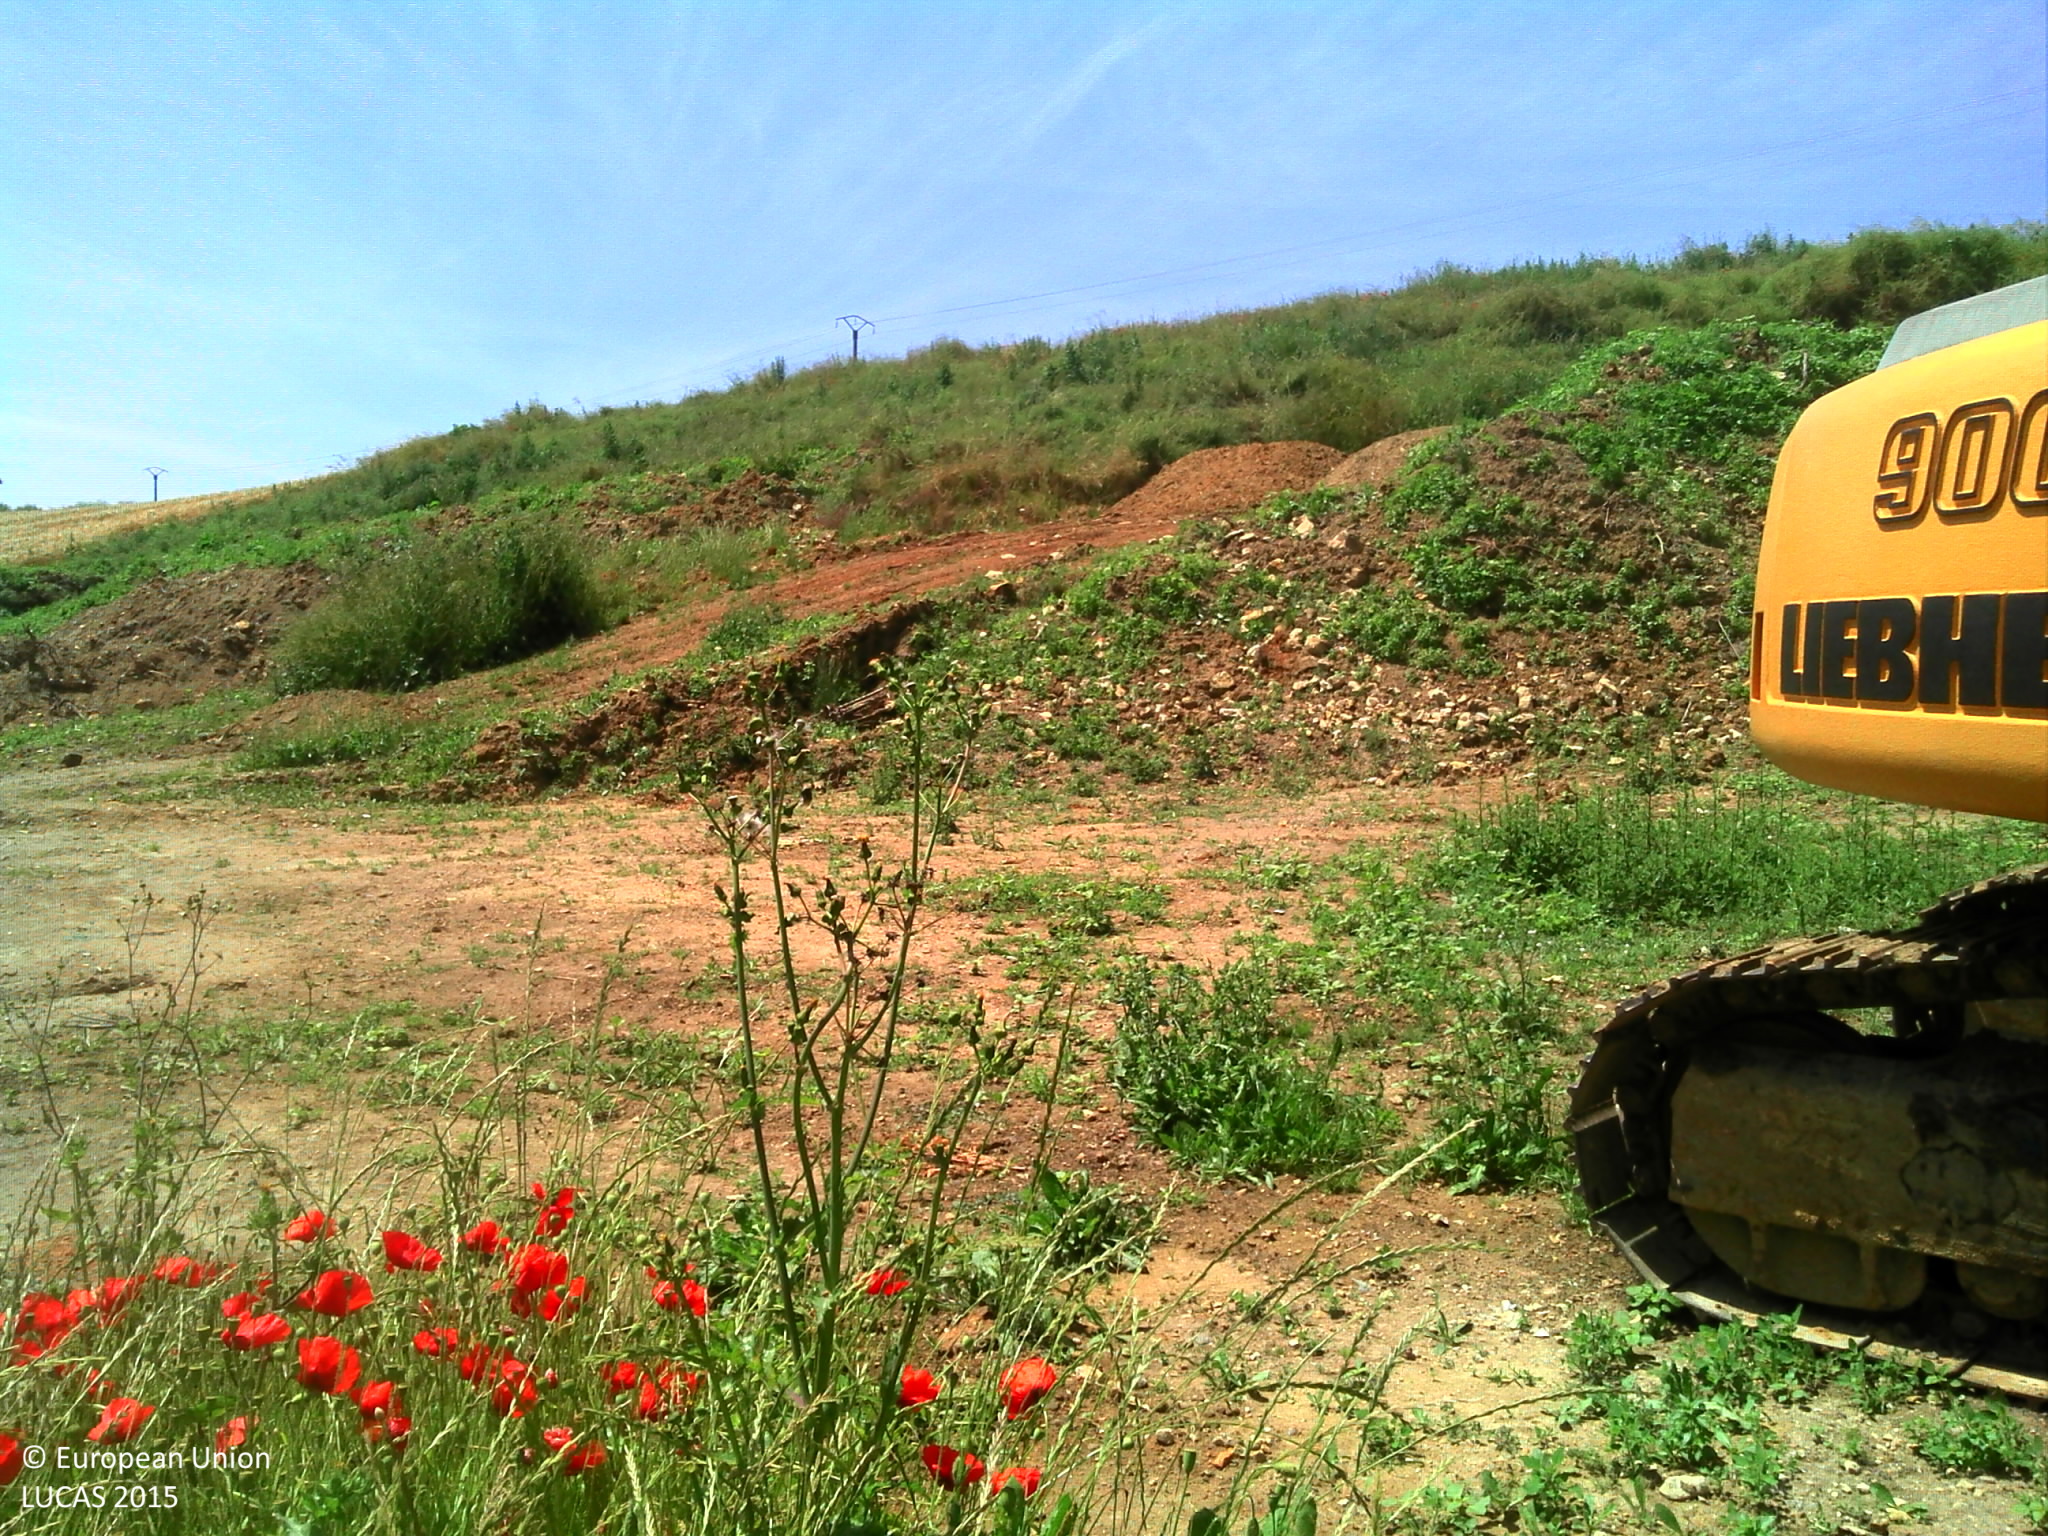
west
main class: Grassland
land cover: Spontaneously vegetated surfaces
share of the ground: 50 - 75 %
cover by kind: herbaceous plants 75 %, consolidated bare surface 25 %
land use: Construction
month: June
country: FR
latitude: 47.6280
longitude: 0.4629
